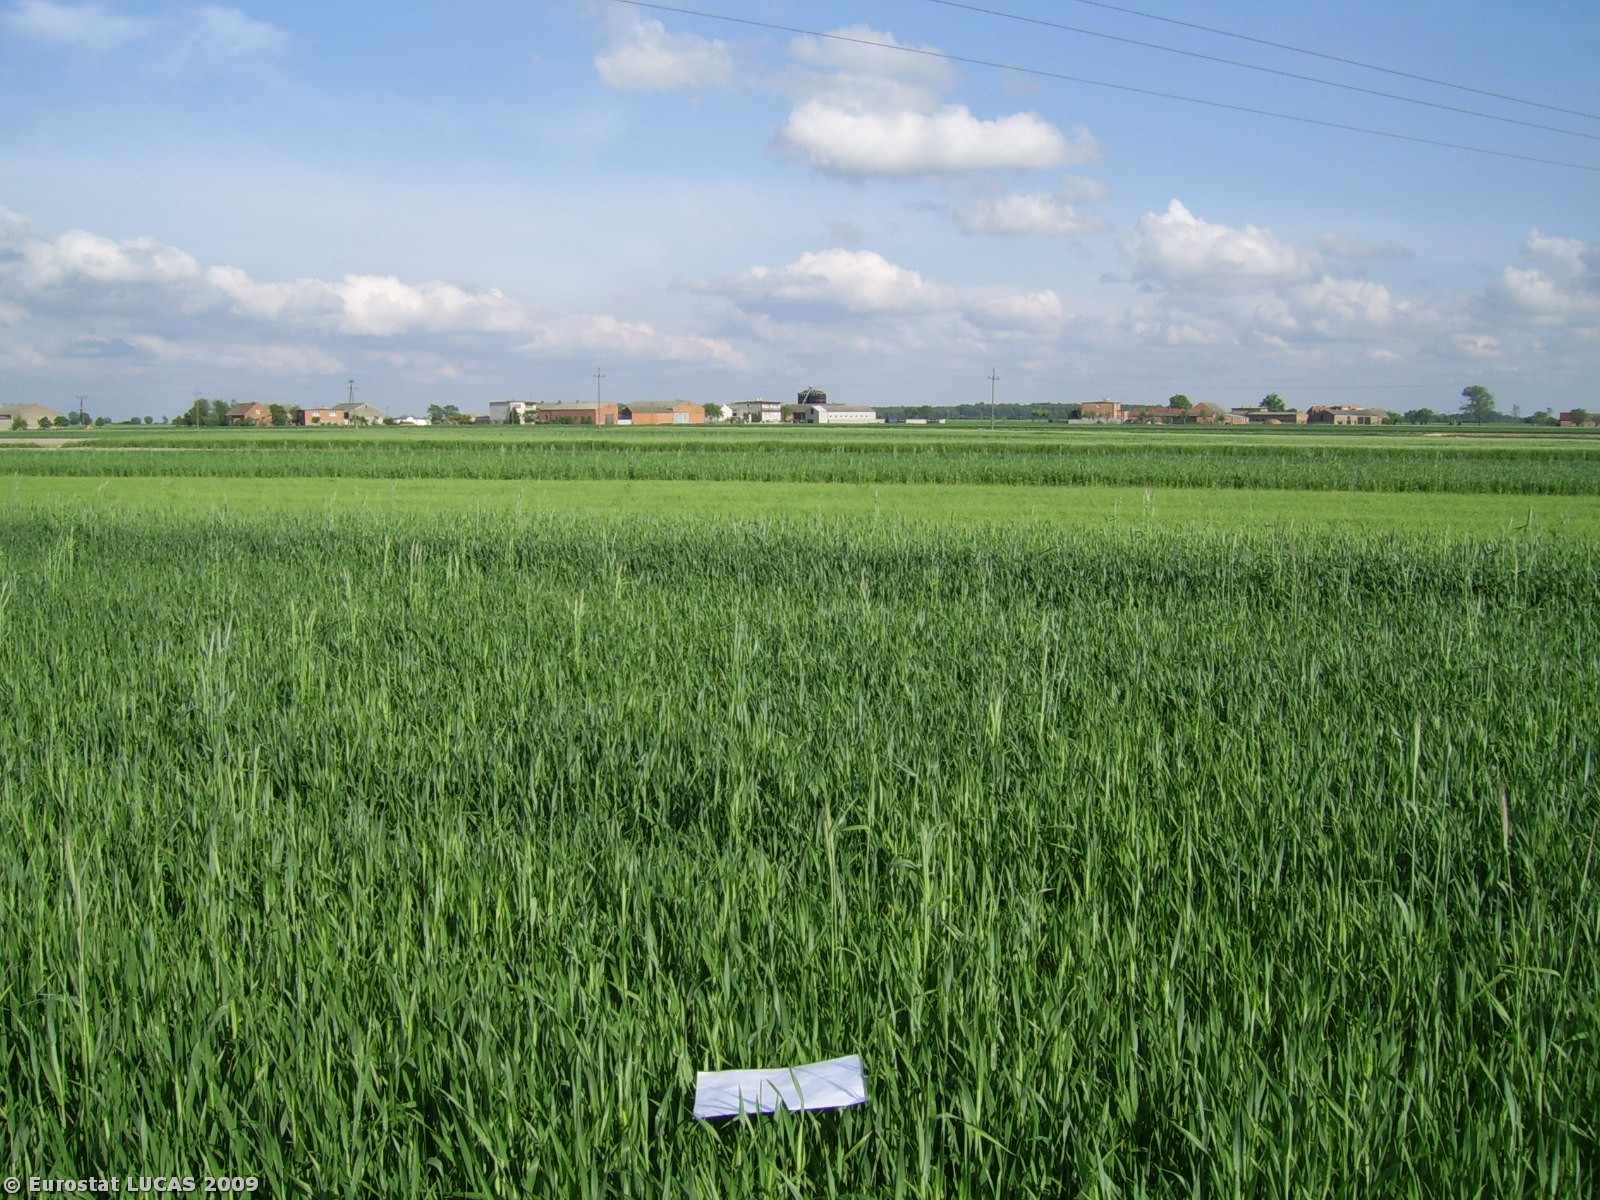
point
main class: Cropland
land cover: Triticale
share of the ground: > 75 %
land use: Agriculture (excluding fallow land and kitchen gardens)
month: May
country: PL
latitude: 51.8533
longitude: 16.8766
